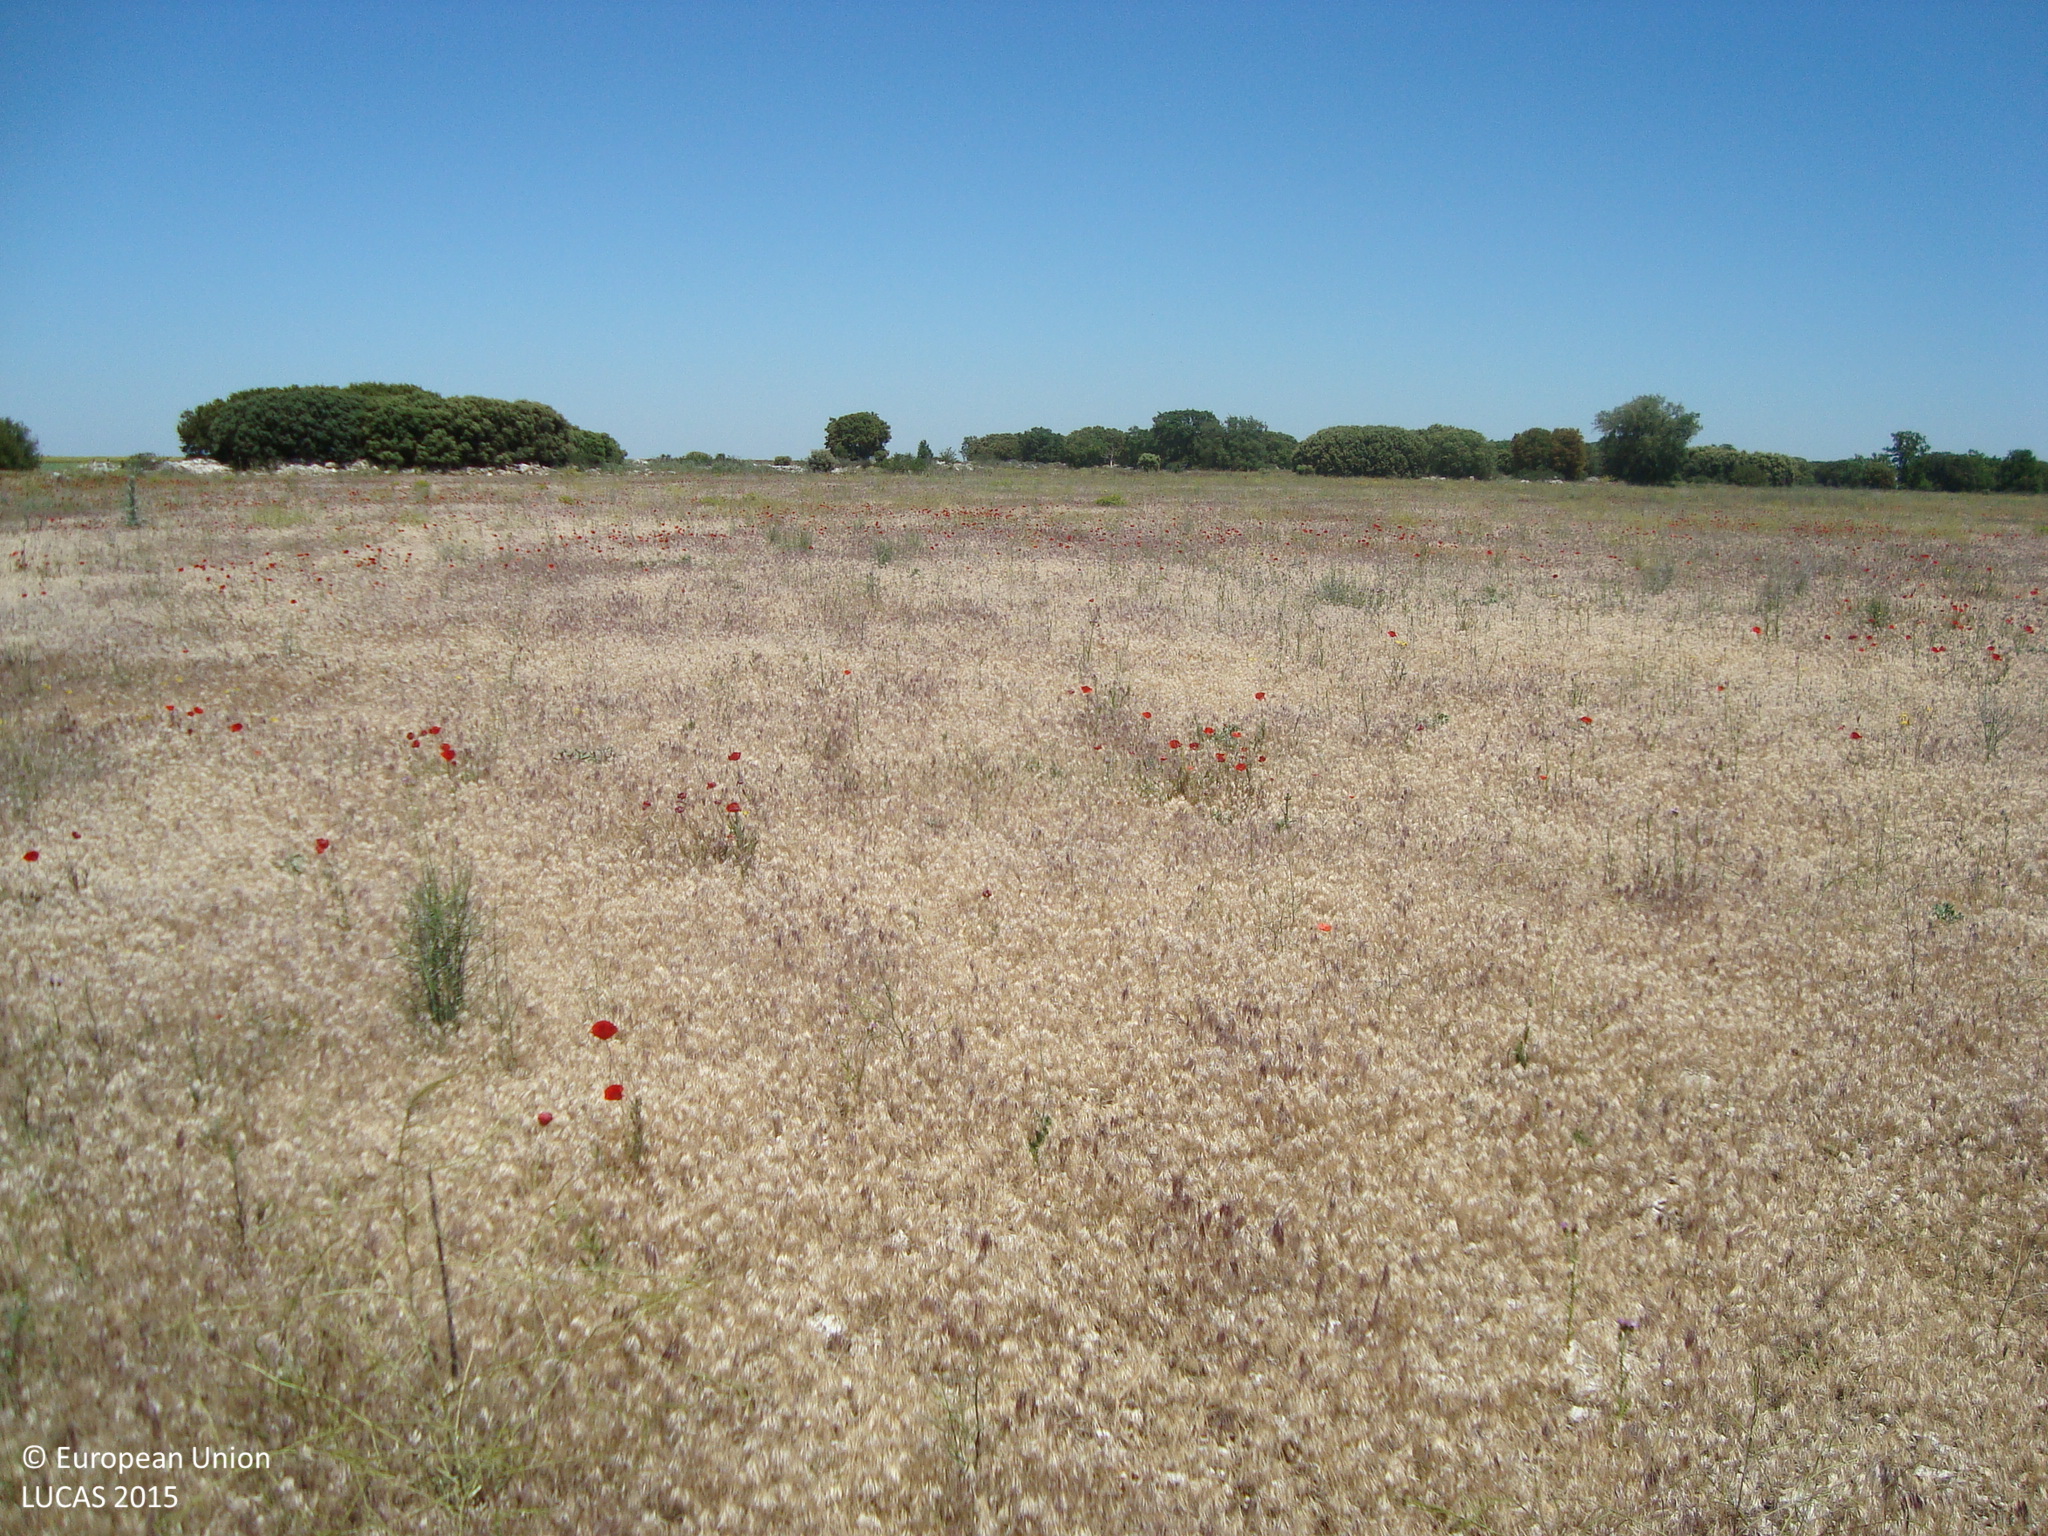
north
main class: Grassland
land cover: Spontaneously vegetated surfaces
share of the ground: > 75 %
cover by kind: herbaceous plants 90 %, unconsolidated bare surface 10 %
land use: Abandoned areas
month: May
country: ES
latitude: 41.5392
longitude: -4.1911
